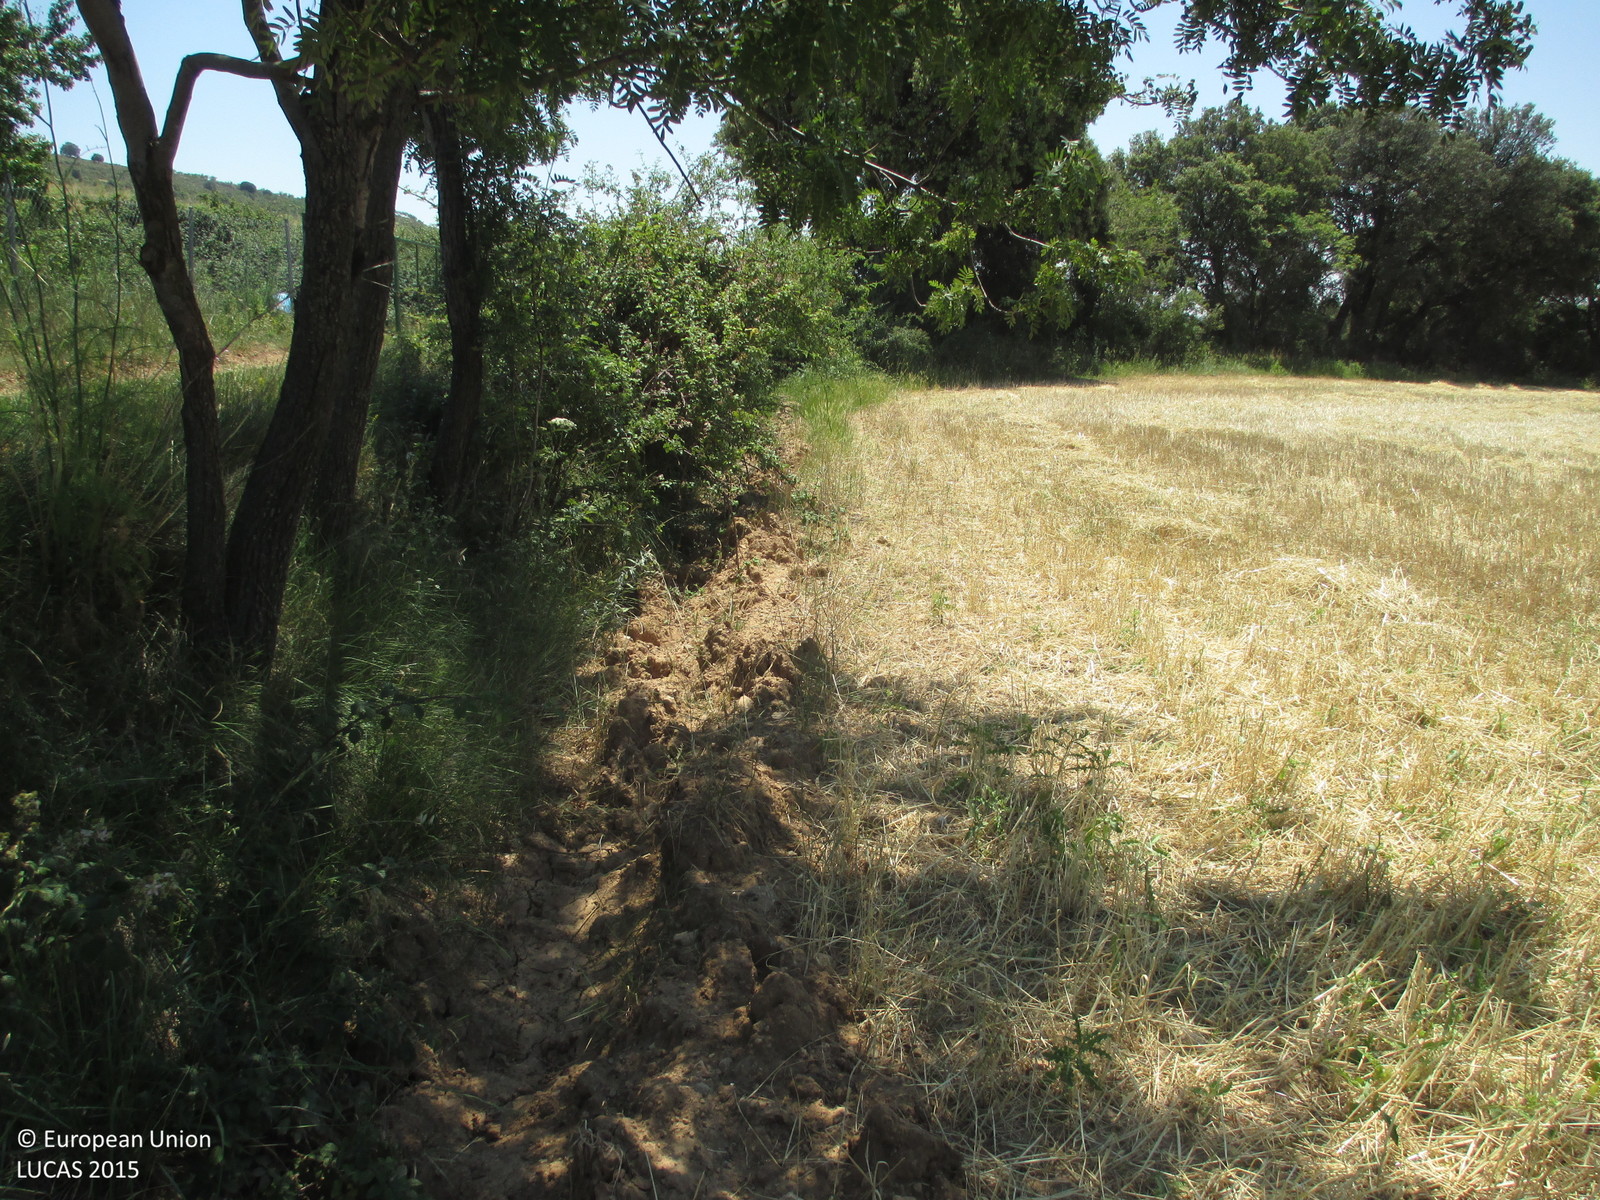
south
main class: Cropland
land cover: Barley
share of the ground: < 10 %
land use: Agriculture (excluding fallow land and kitchen gardens)
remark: Harvested field
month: June
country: ES
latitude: 42.2590
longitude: -0.4366
